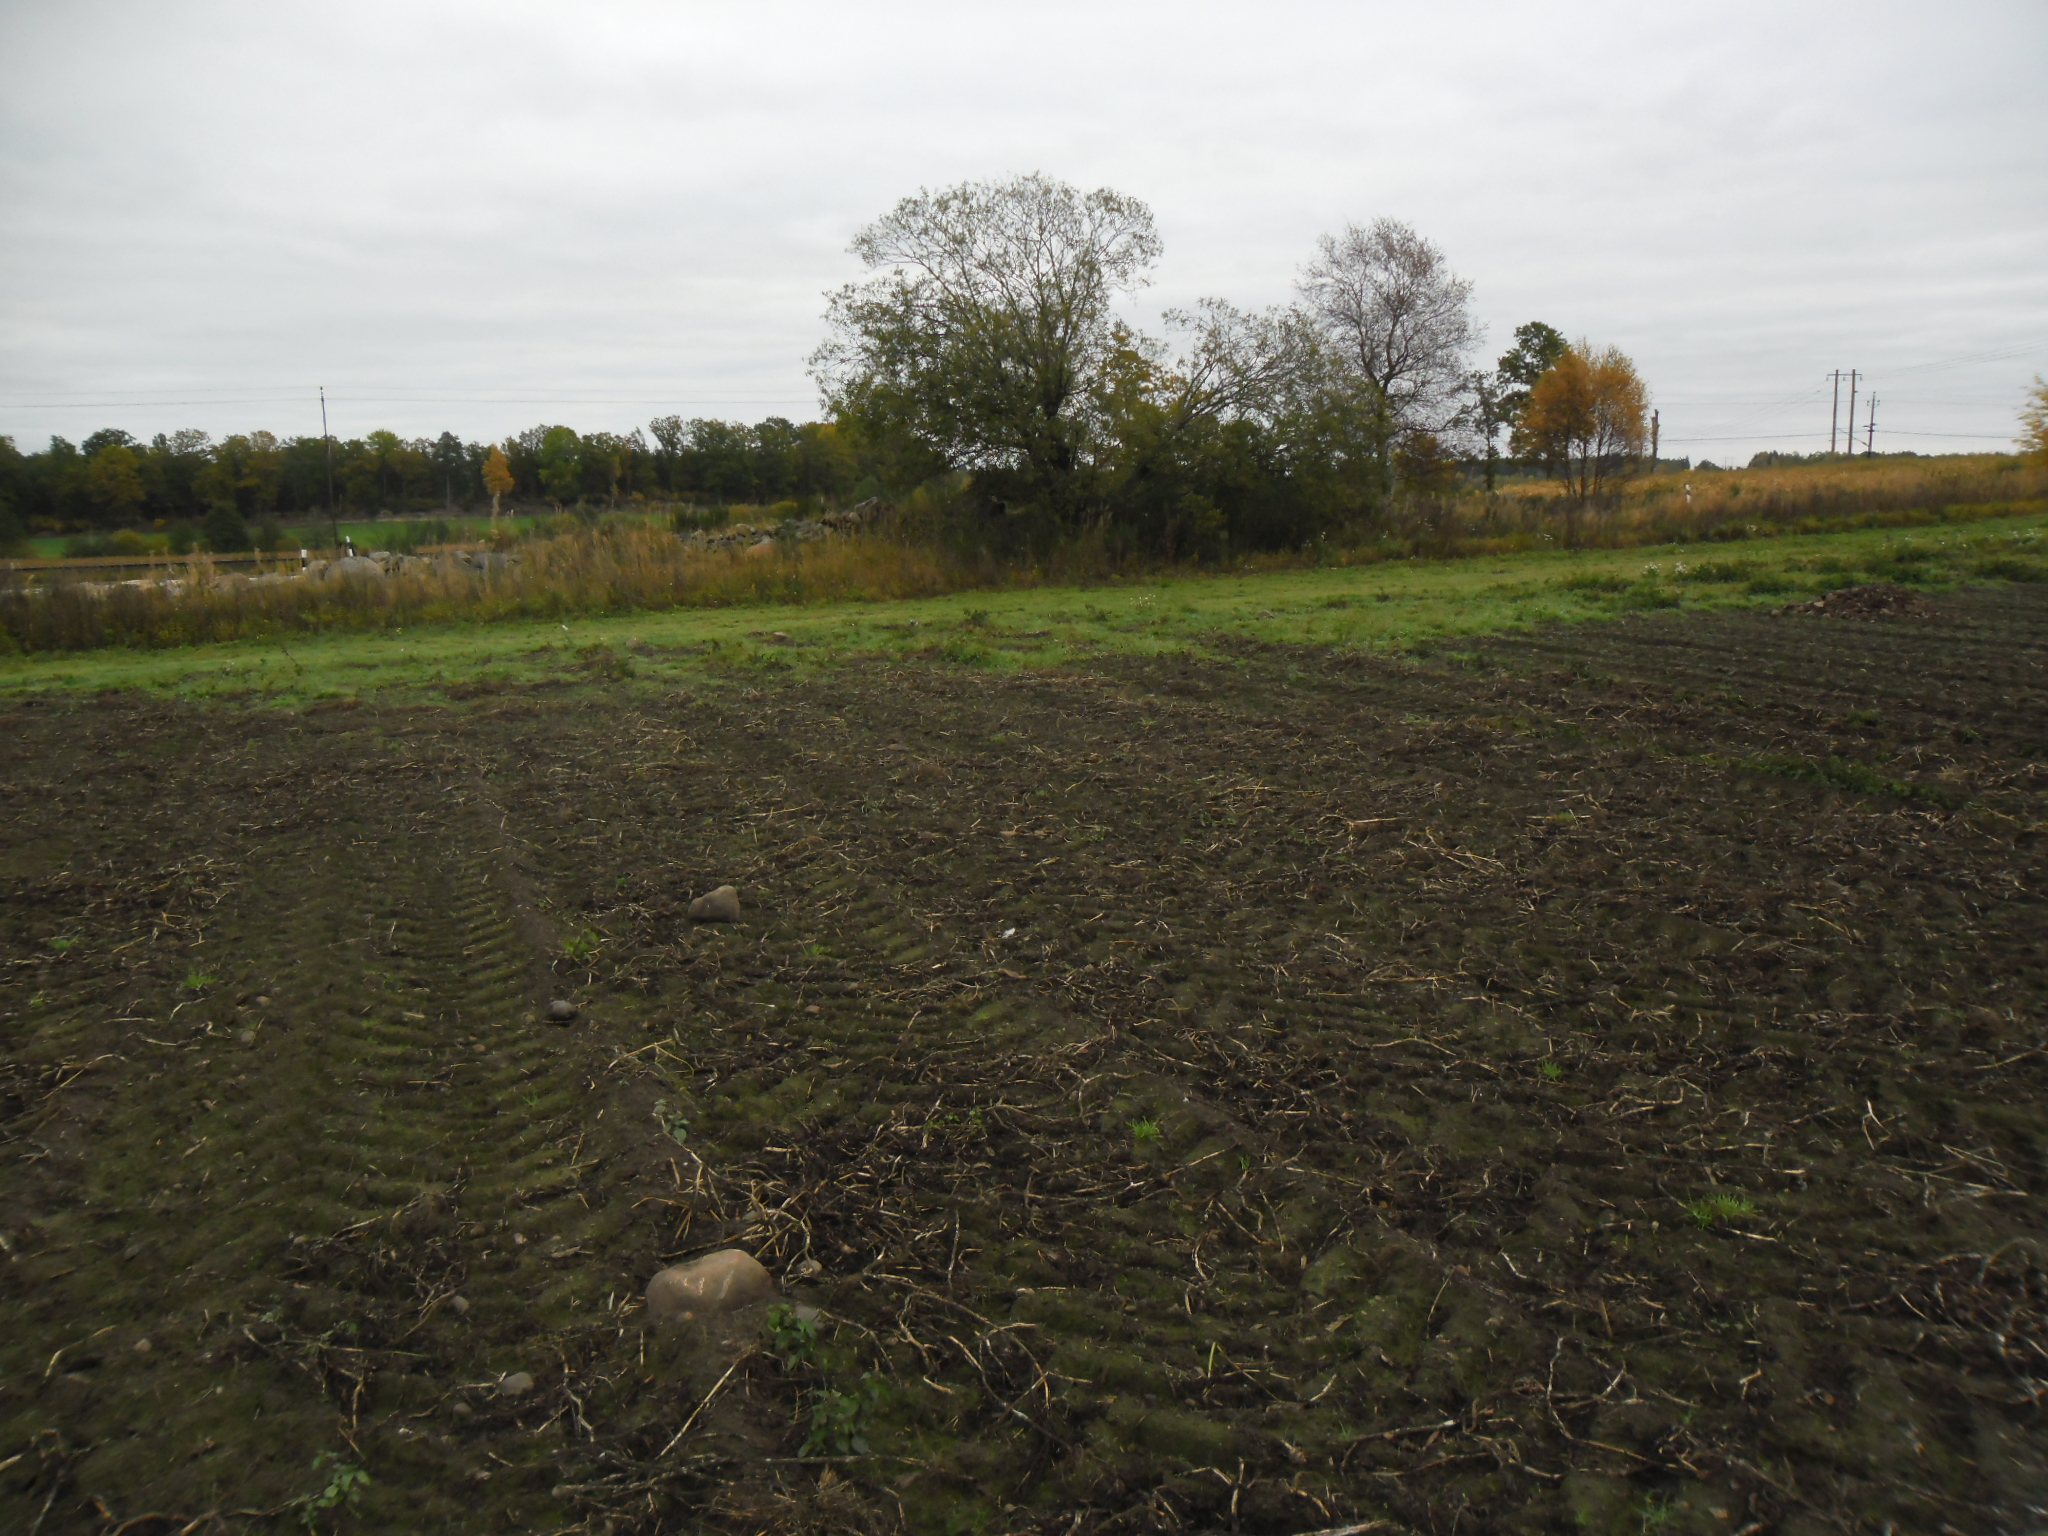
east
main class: Cropland
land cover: Potatoes
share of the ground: < 10 %
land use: Agriculture (excluding fallow land and kitchen gardens)
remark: Harvested field
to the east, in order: Potatoes; Abandoned hedges; Grass margins; Paved roads, cycling and walking lanes; Grassland without tree/shrub cover; Abandoned hedges; Fences; Grassland without tree/shrub cover; Fences; Grass margins; Railways; Spontaneously vegetated surfaces; Tracks; Grass margins; Maize
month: October
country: SE
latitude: 56.1870
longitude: 13.7517
